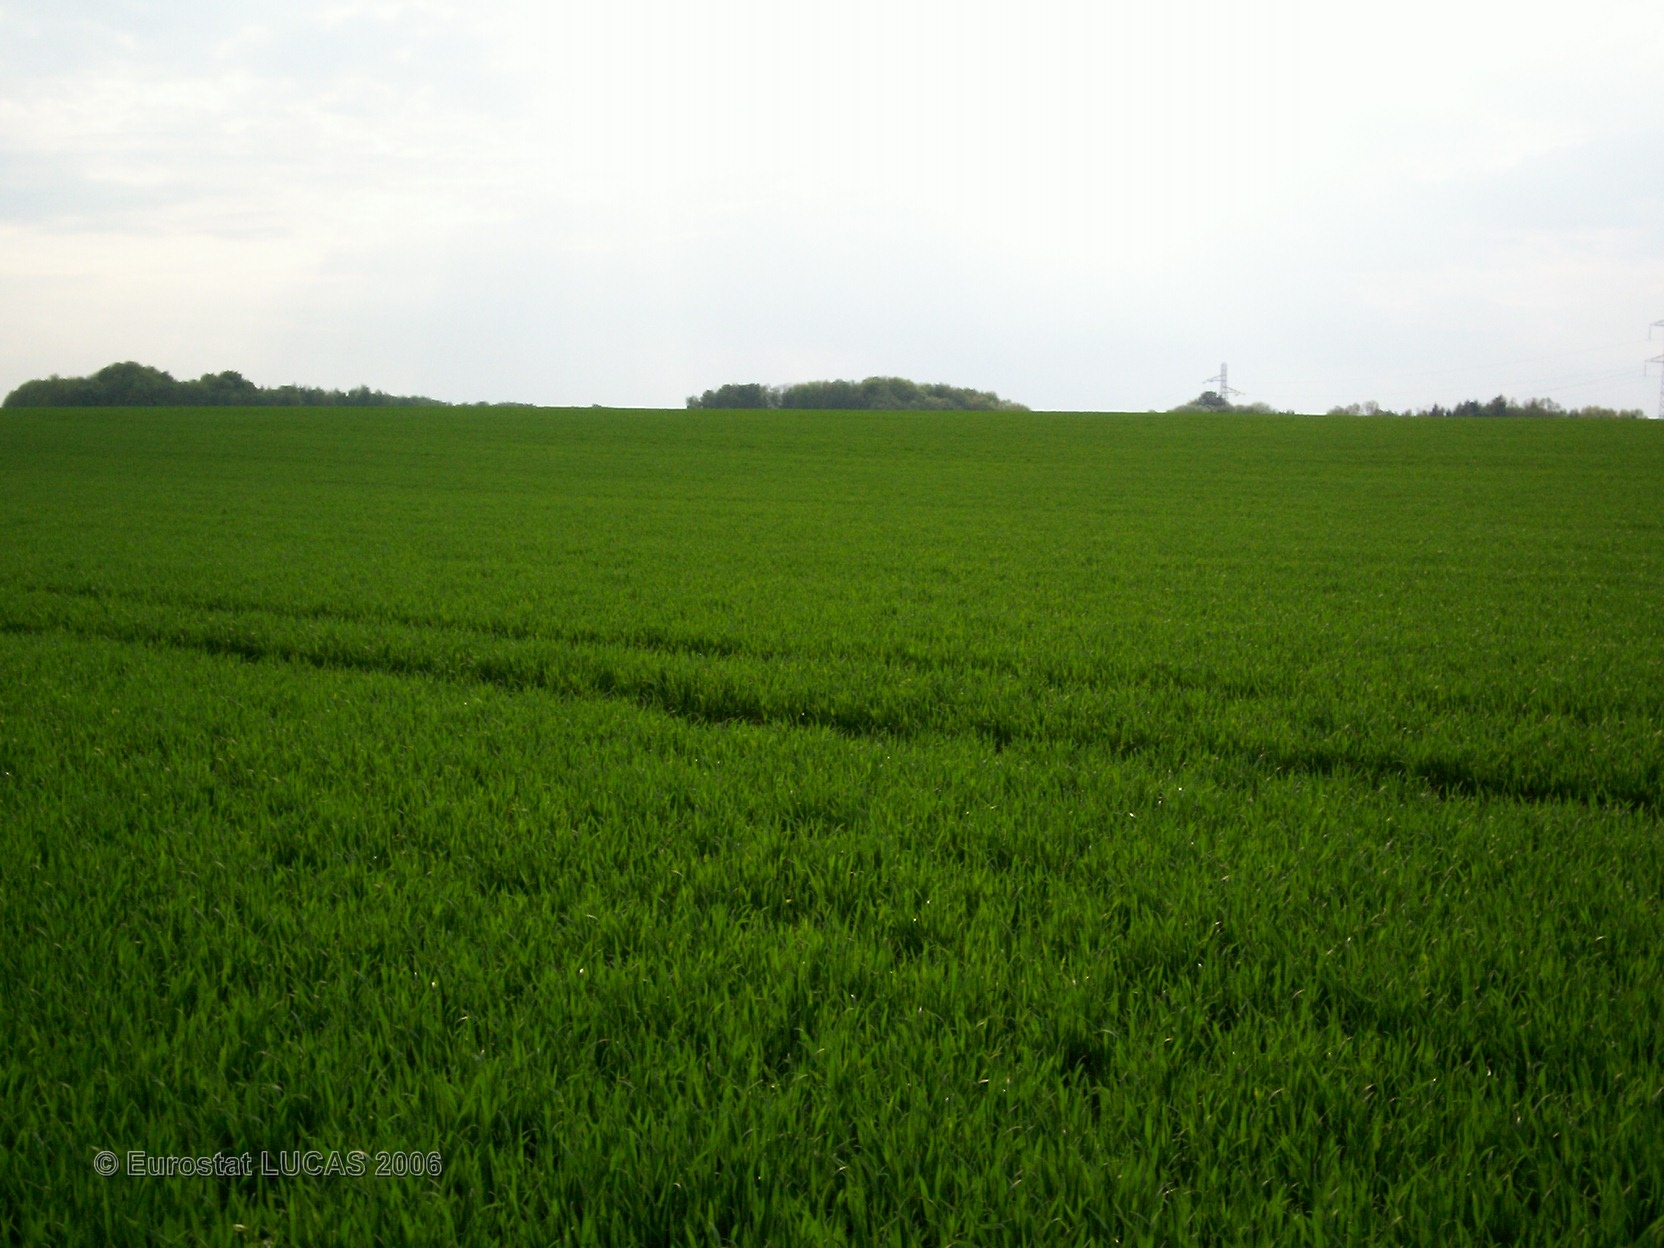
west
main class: Cropland
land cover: Common wheat
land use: Agriculture (excluding fallow land and kitchen gardens)
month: May
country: FR
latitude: 47.5736
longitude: 7.1169
